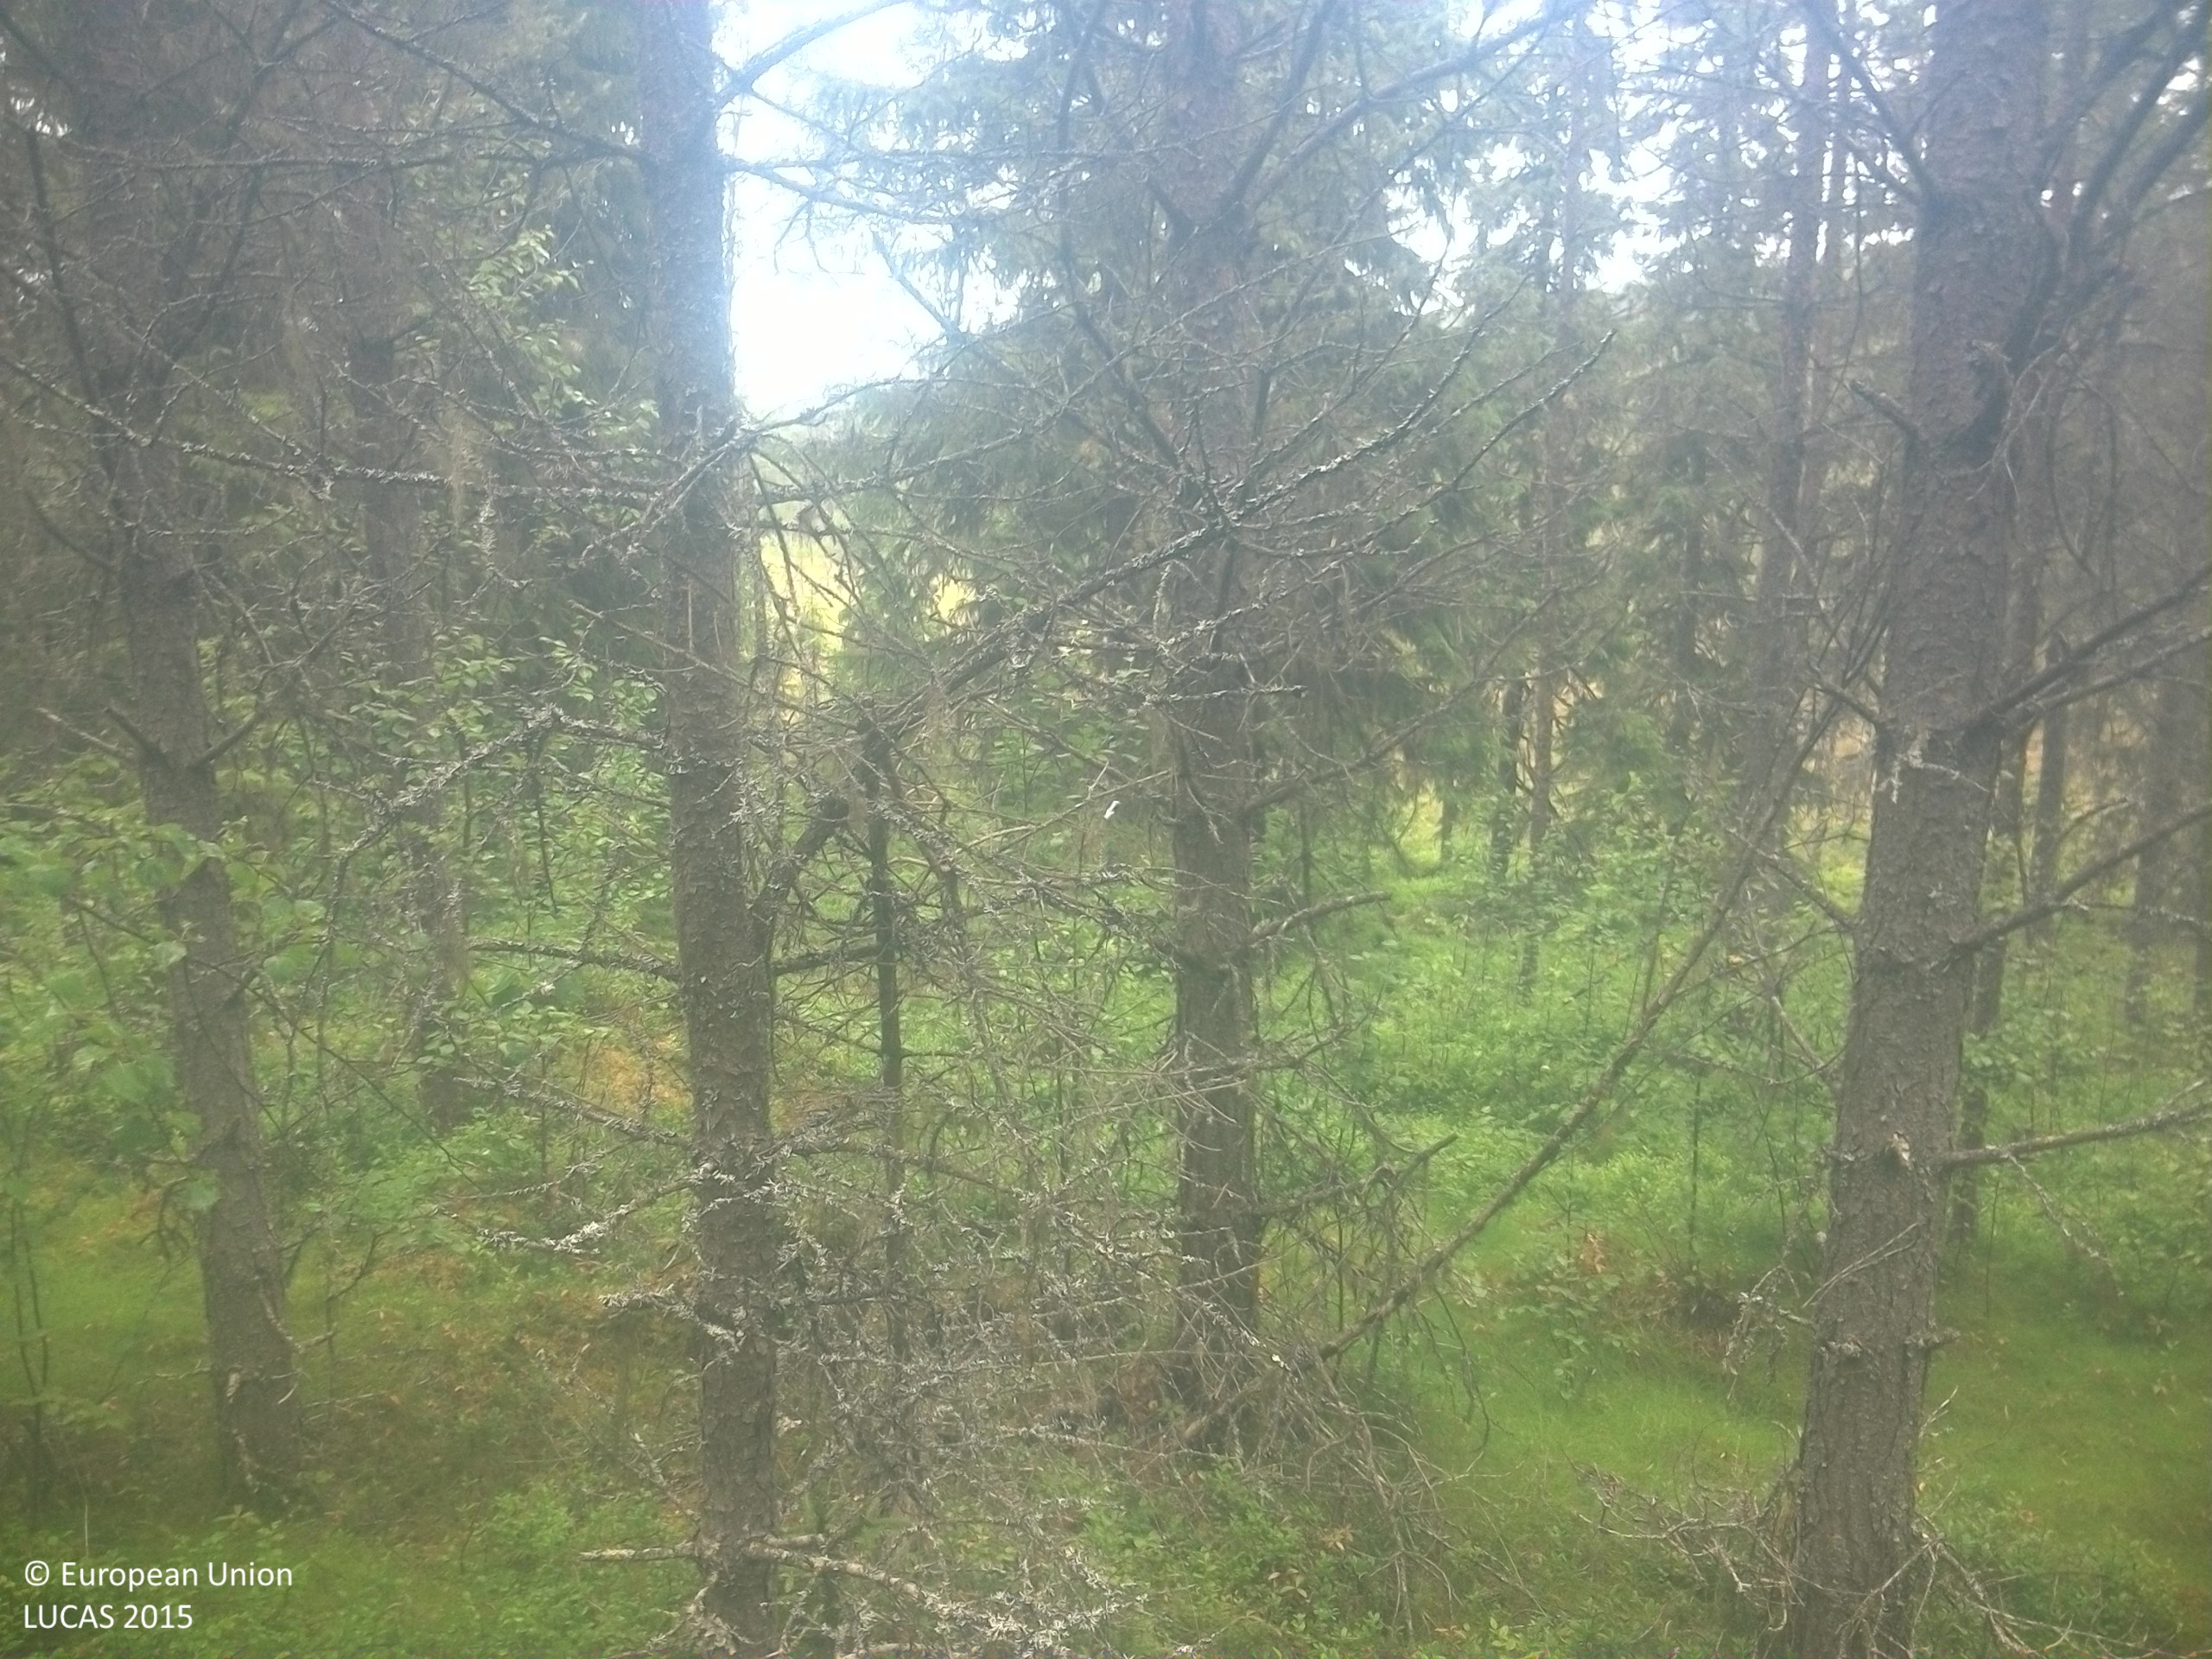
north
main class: Woodland
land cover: Pine dominated coniferous woodland
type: boreal forest
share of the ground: 50 - 75 %
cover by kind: coniferous forest trees 45 %, shrubs 20 %, herbaceous plants 15 %, broadleaved forest trees 10 %, lichens and mosses 10 %
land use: Forestry
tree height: > 5 m
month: August
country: SE
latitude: 63.5364
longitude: 16.5908
